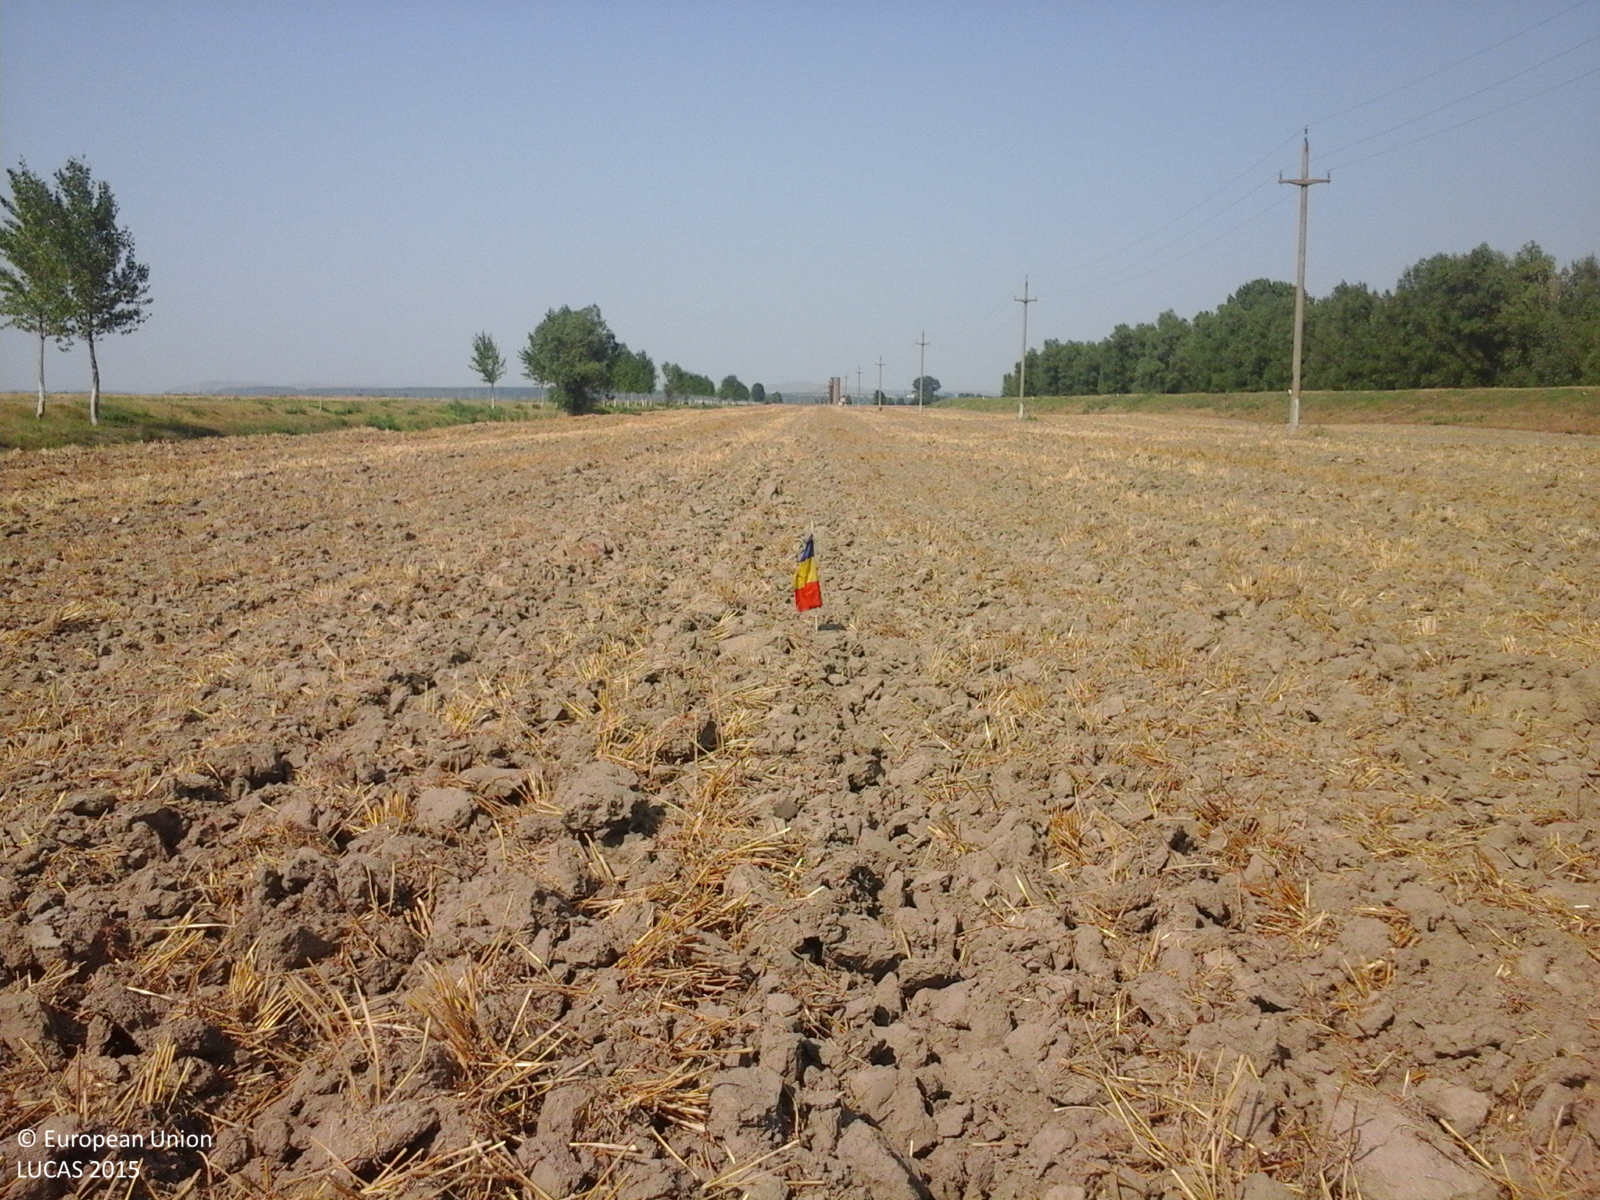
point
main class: Cropland
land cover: Common wheat
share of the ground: < 10 %
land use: Agriculture (excluding fallow land and kitchen gardens)
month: August
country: RO
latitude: 44.8642
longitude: 28.0987
